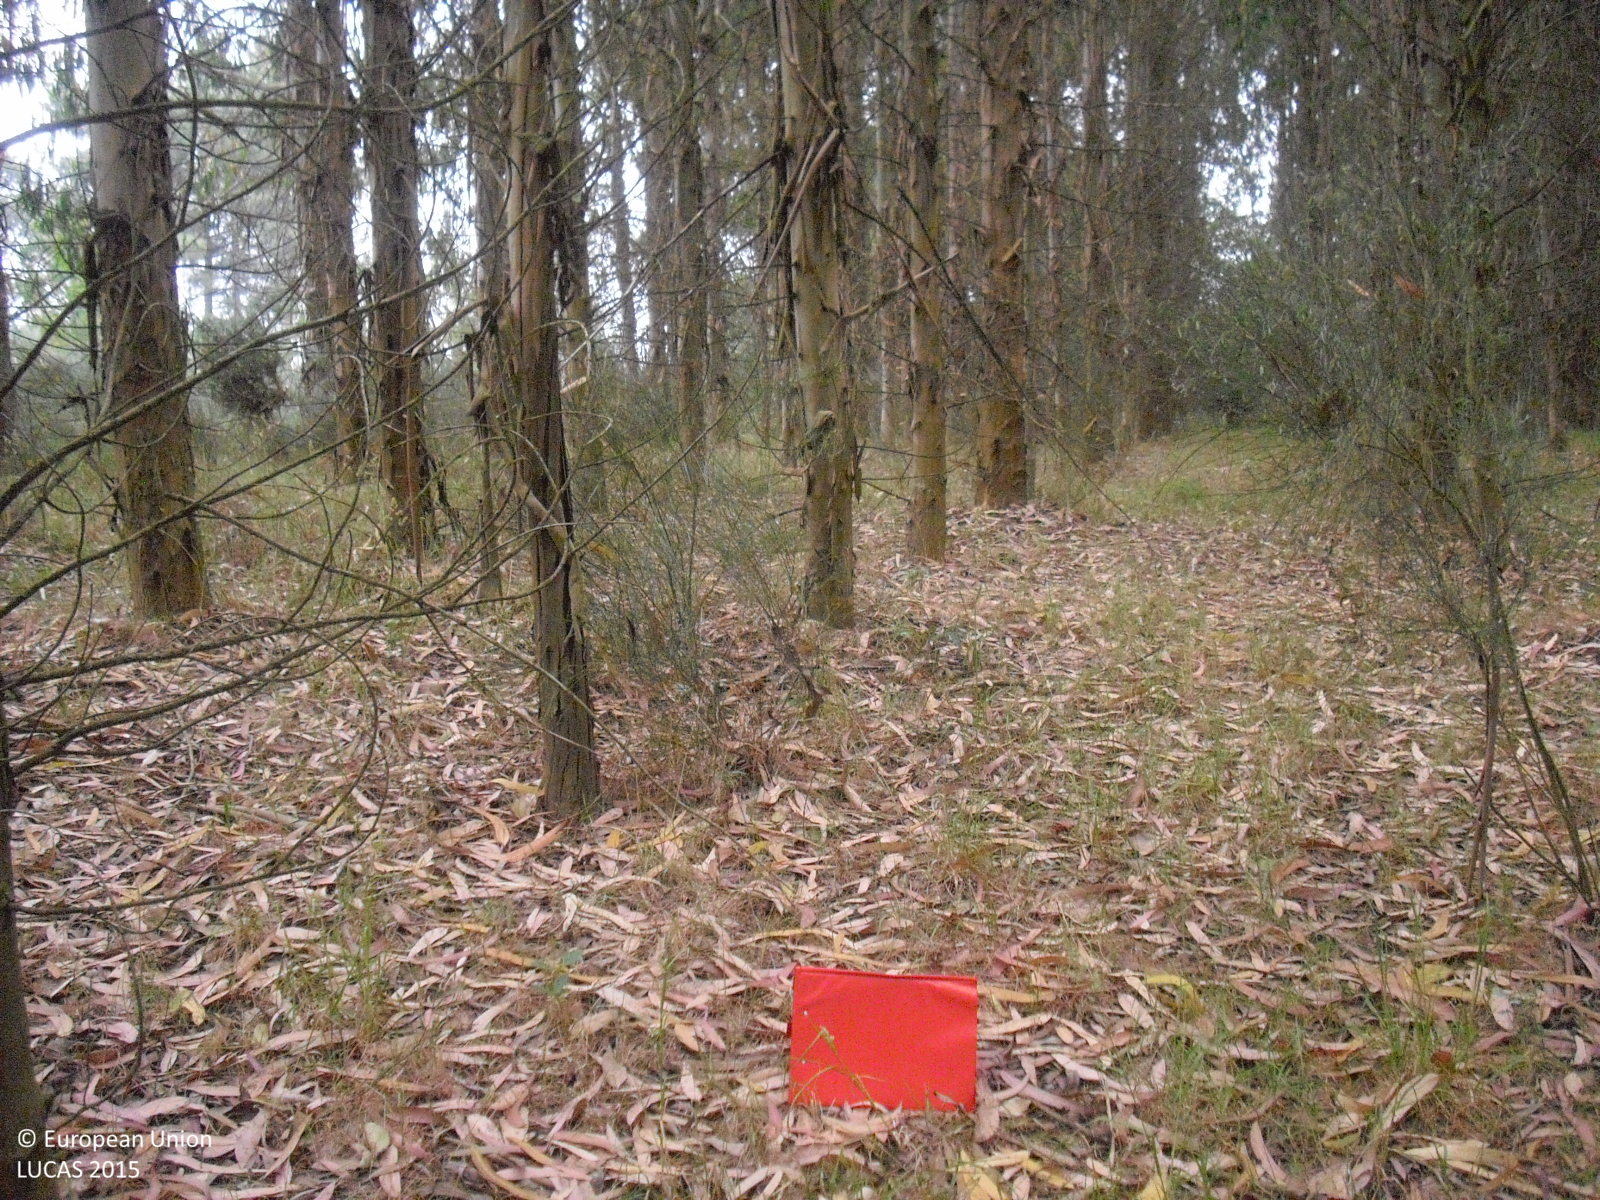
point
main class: Woodland
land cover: Broadleaved woodland
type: exotic forest
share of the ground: > 75 %
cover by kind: broadleaved forest trees 100 %
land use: Forestry
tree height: > 5 m
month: June
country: ES
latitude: 42.7665
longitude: -7.8637
